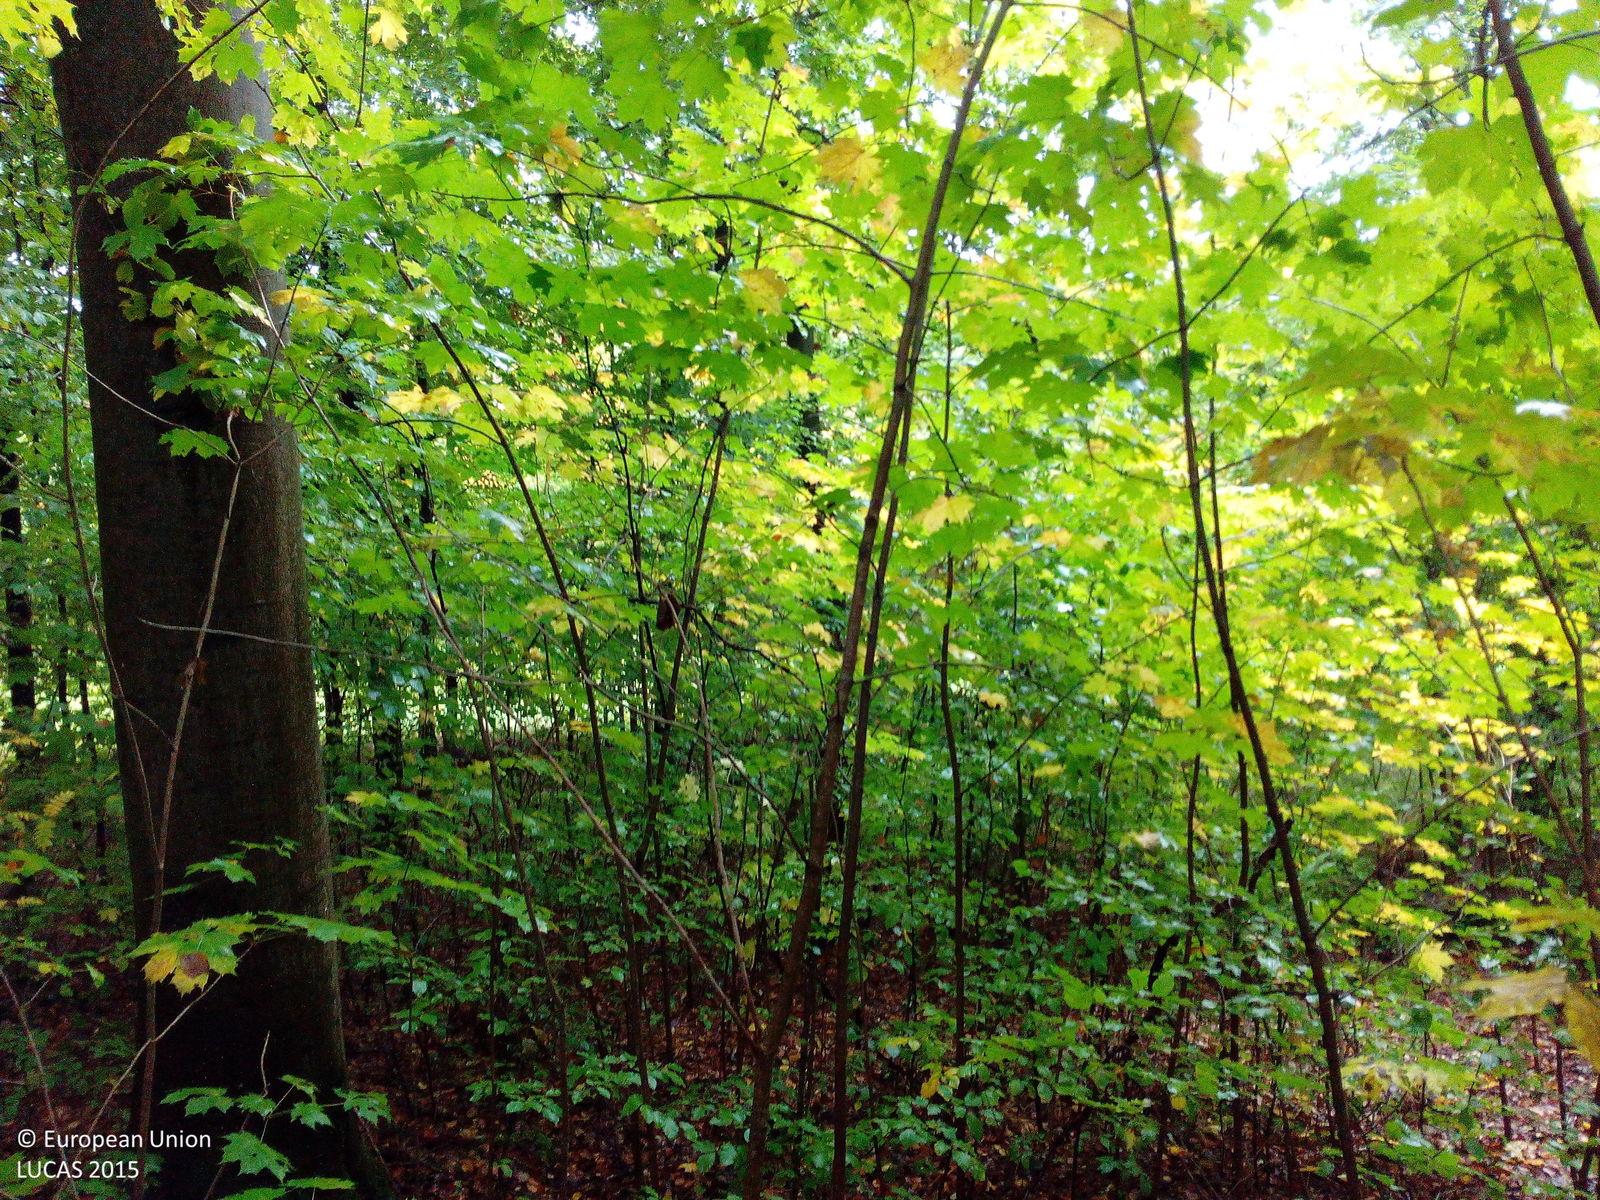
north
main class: Woodland
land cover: Broadleaved woodland
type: beech forest
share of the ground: 50 - 75 %
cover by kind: broadleaved forest trees 70 %, unconsolidated bare surface 15 %, shrubs 10 %, herbaceous plants 5 %
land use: Forestry
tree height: > 5 m
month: October
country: DE
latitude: 50.0943
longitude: 9.9022
